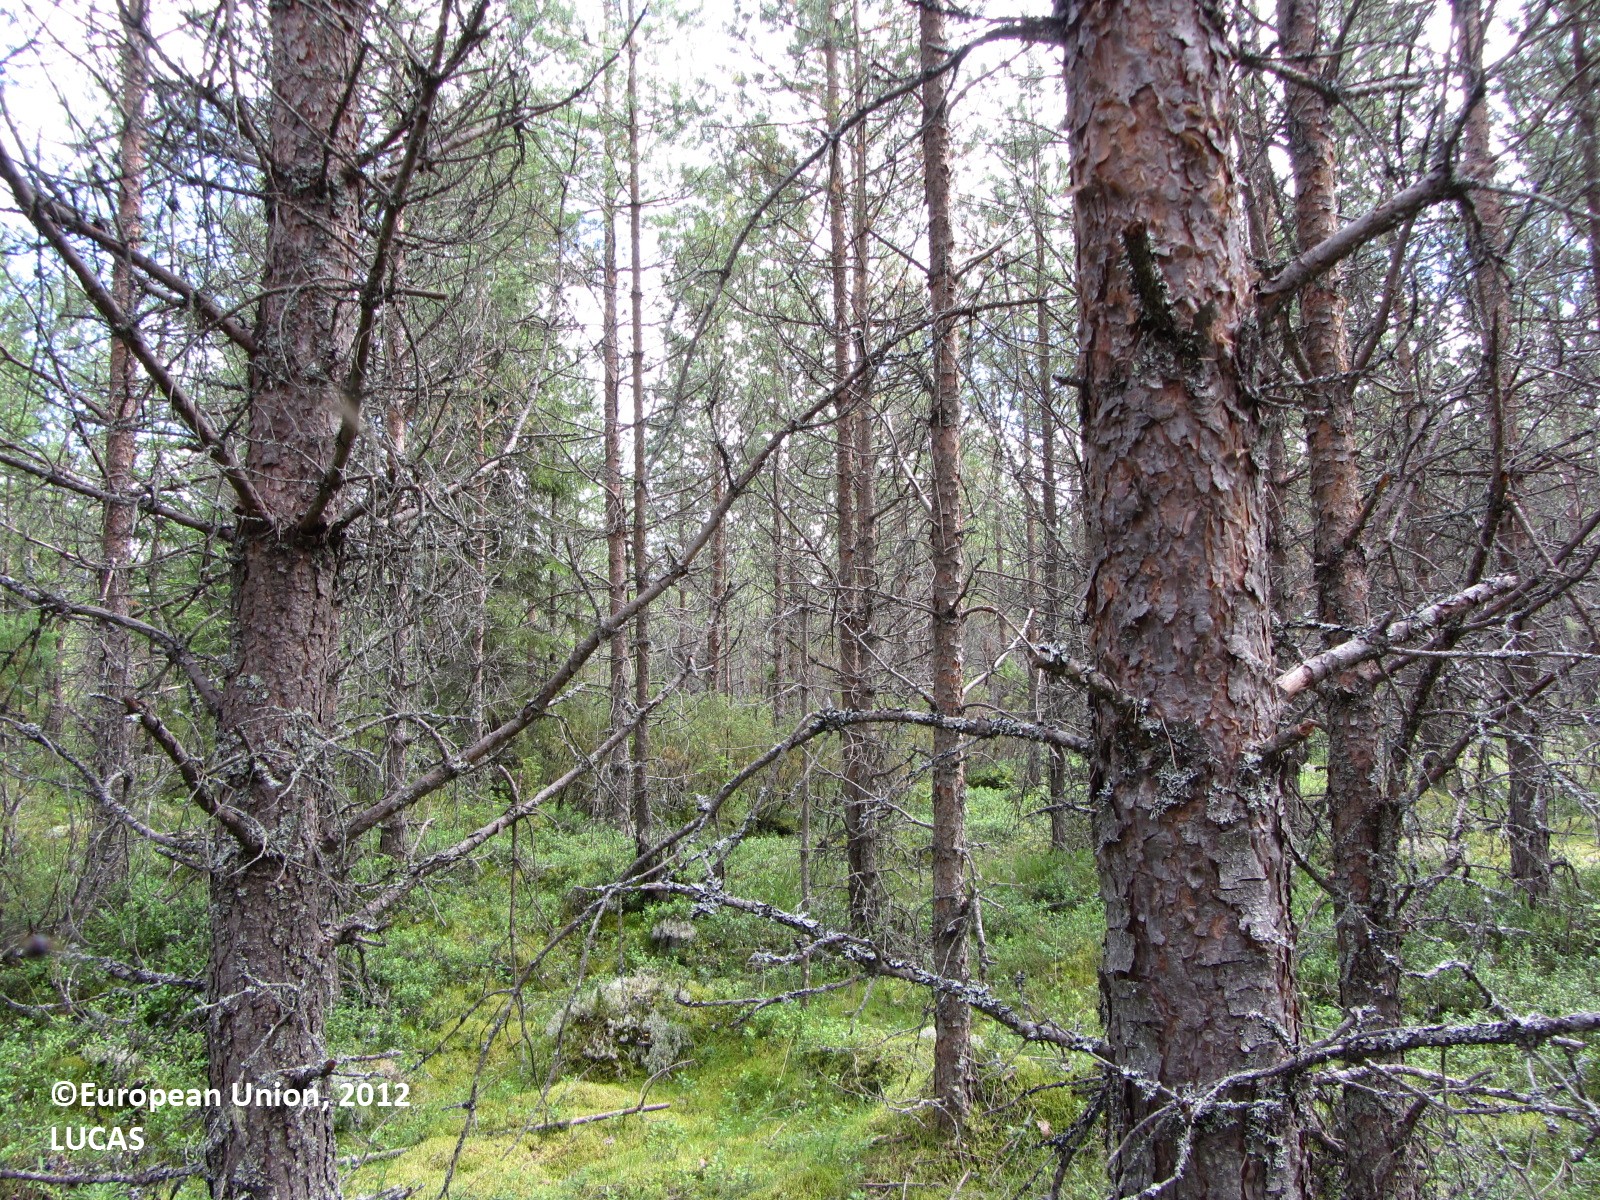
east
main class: Woodland
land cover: Pine dominated coniferous woodland
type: boreal forest
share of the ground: > 75 %
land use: Forestry
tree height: > 5 m
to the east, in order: Pine dominated coniferous woodland; Shrubland with sparse tree cover; Pine dominated coniferous woodland; Rock outcrops; Pine dominated coniferous woodland; Grassland with sparse tree/shrub cover; Ditches and canals; Paved roads, cycling and walking lanes; Ditches and canals; Shrubland with sparse tree cover
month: July
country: FI
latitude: 63.6029
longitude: 25.3997
